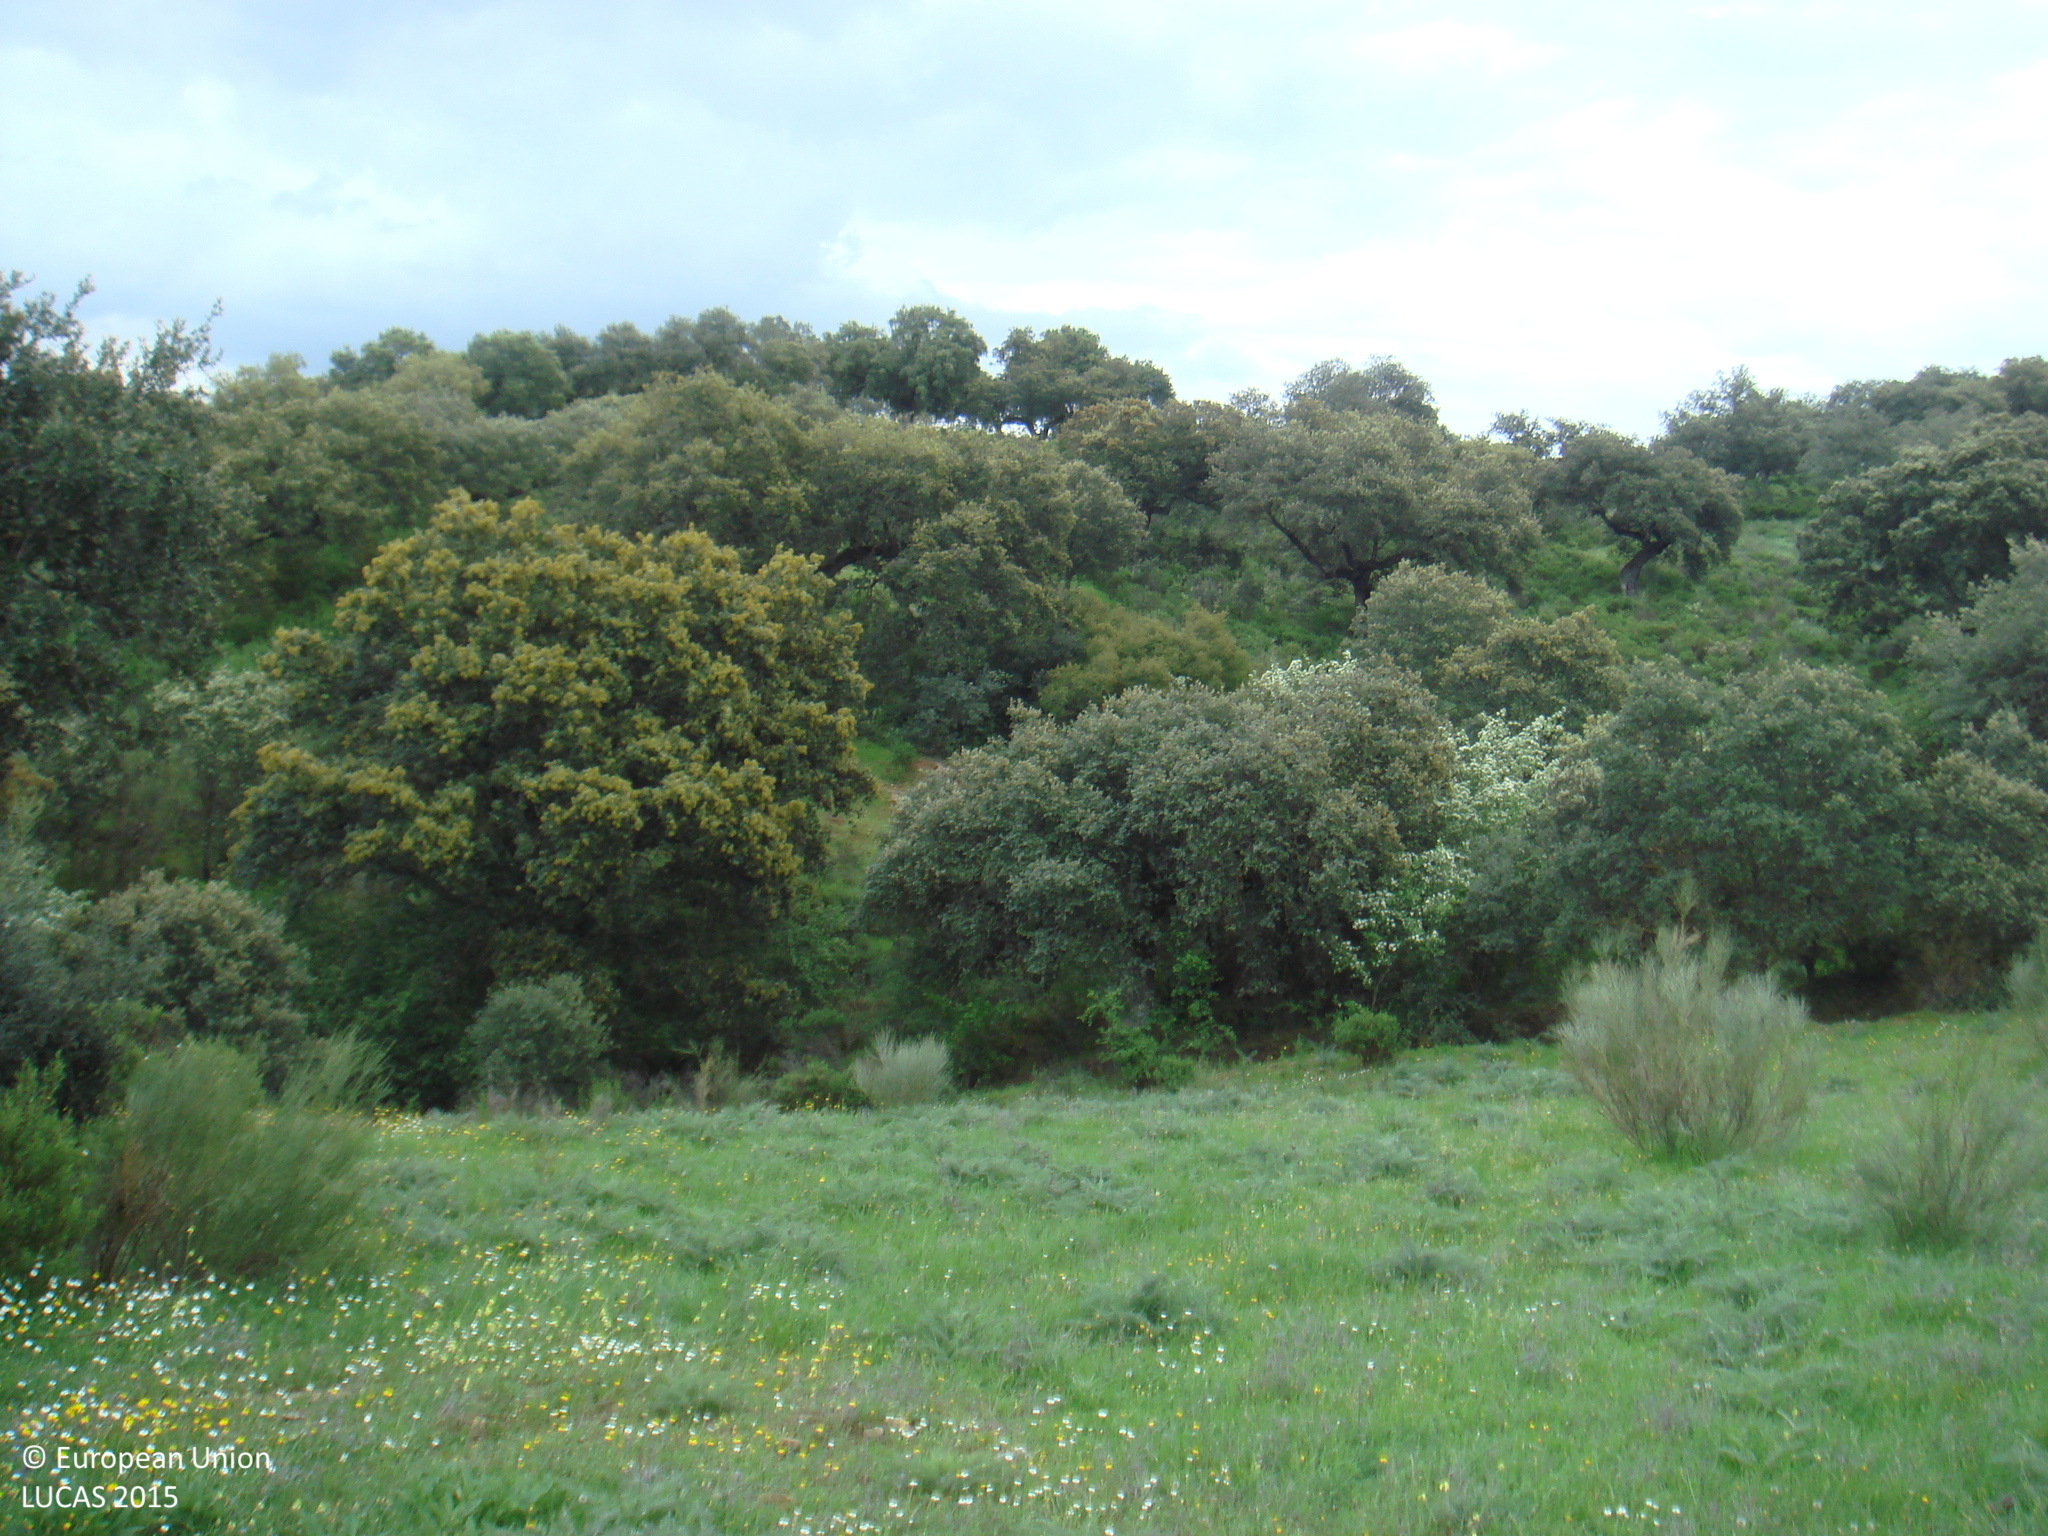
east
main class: Shrubland
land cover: Shrubland with sparse tree cover
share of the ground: > 75 %
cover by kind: shrubs 70 %, herbaceous plants 25 %, broadleaved forest trees 5 %
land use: Forestry
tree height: > 5 m
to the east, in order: Shrubland with sparse tree cover; Broadleaved woodland; Rivers and streams; Broadleaved woodland
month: April
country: ES
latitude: 38.1823
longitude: -5.0354
